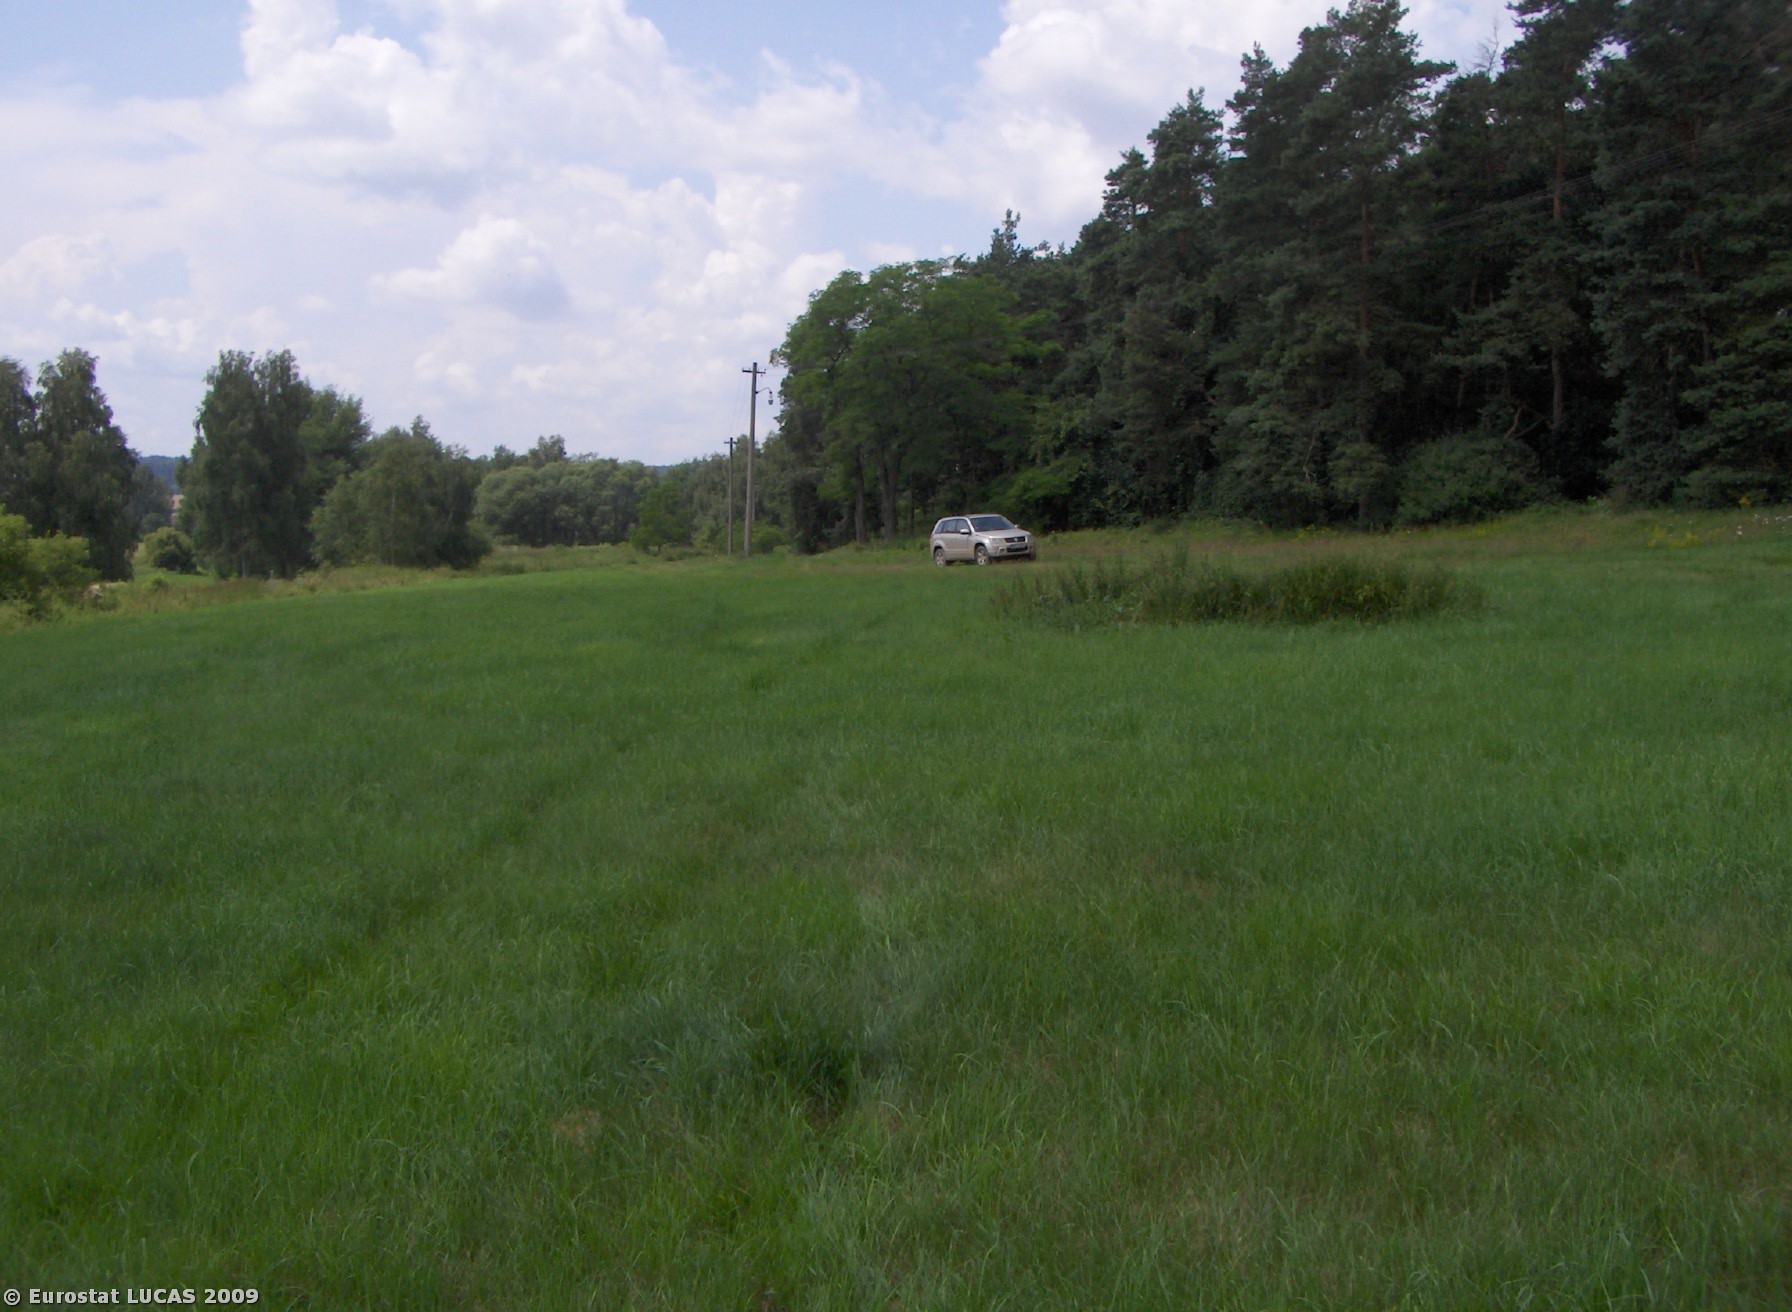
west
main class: Grassland
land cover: Grassland without tree/shrub cover
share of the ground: > 75 %
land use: Agriculture (excluding fallow land and kitchen gardens)
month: July
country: CZ
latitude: 49.5816
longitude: 13.1949
